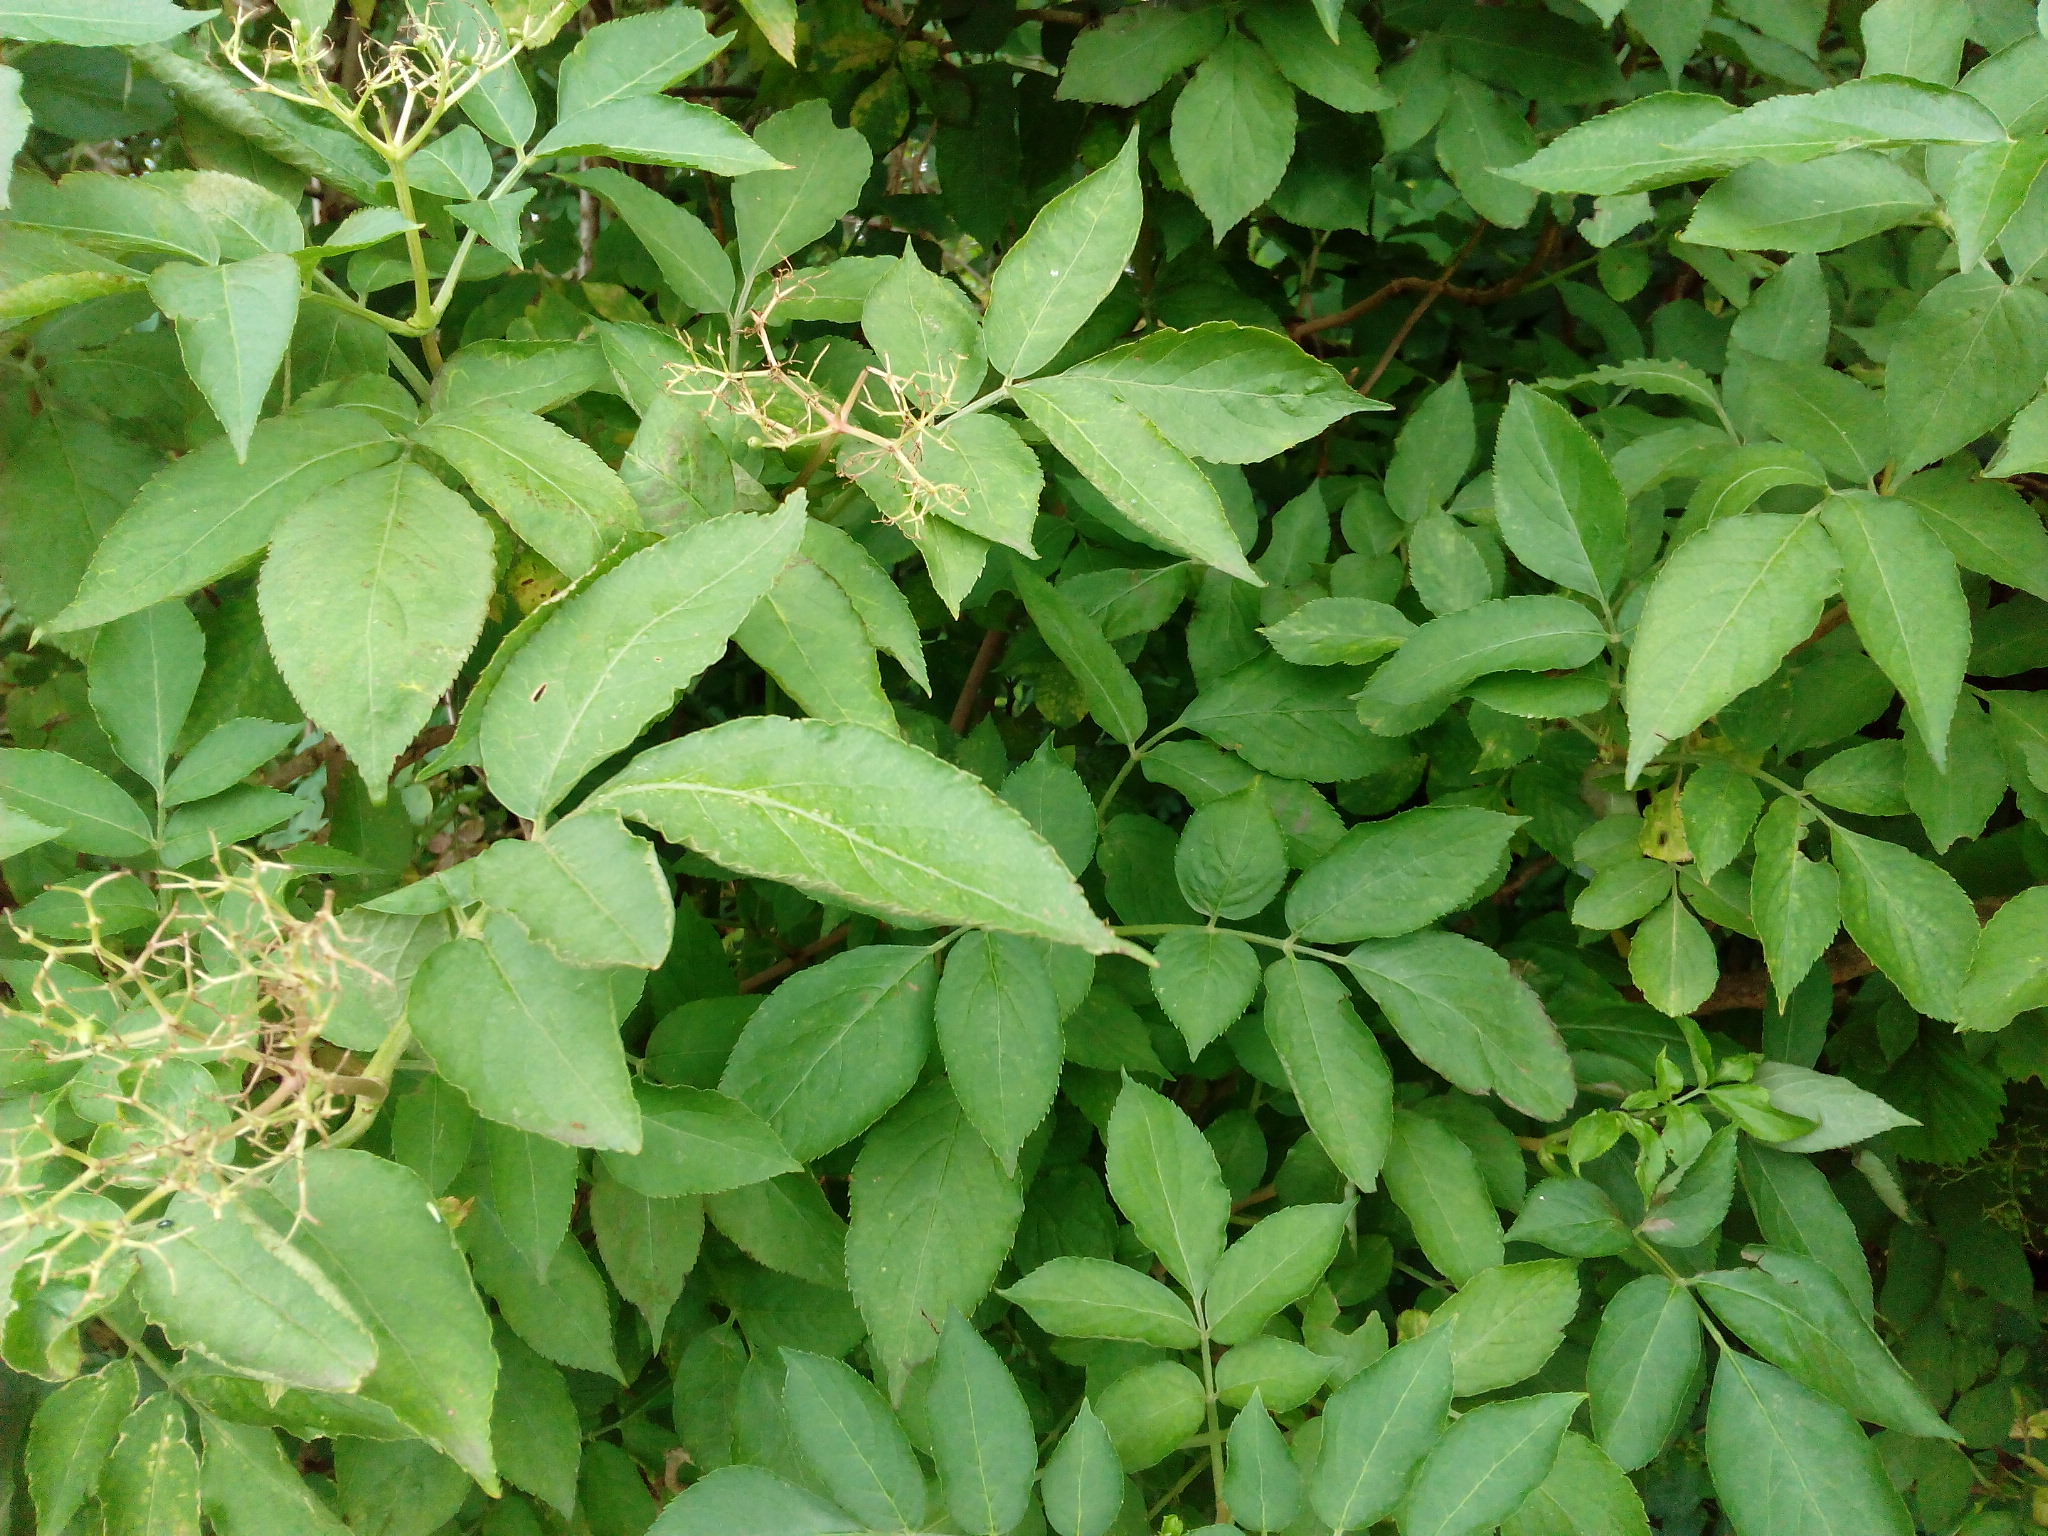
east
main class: Woodland
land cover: Broadleaved woodland
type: mesophytic deciduous forest
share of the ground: > 75 %
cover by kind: broadleaved forest trees 90 %, herbaceous plants 5 %, consolidated bare surface 5 %
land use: Semi-natural and natural areas not in use
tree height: > 5 m
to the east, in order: Broadleaved woodland; Fences; Grassland without tree/shrub cover
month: July
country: DE
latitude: 53.3474
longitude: 14.1917
